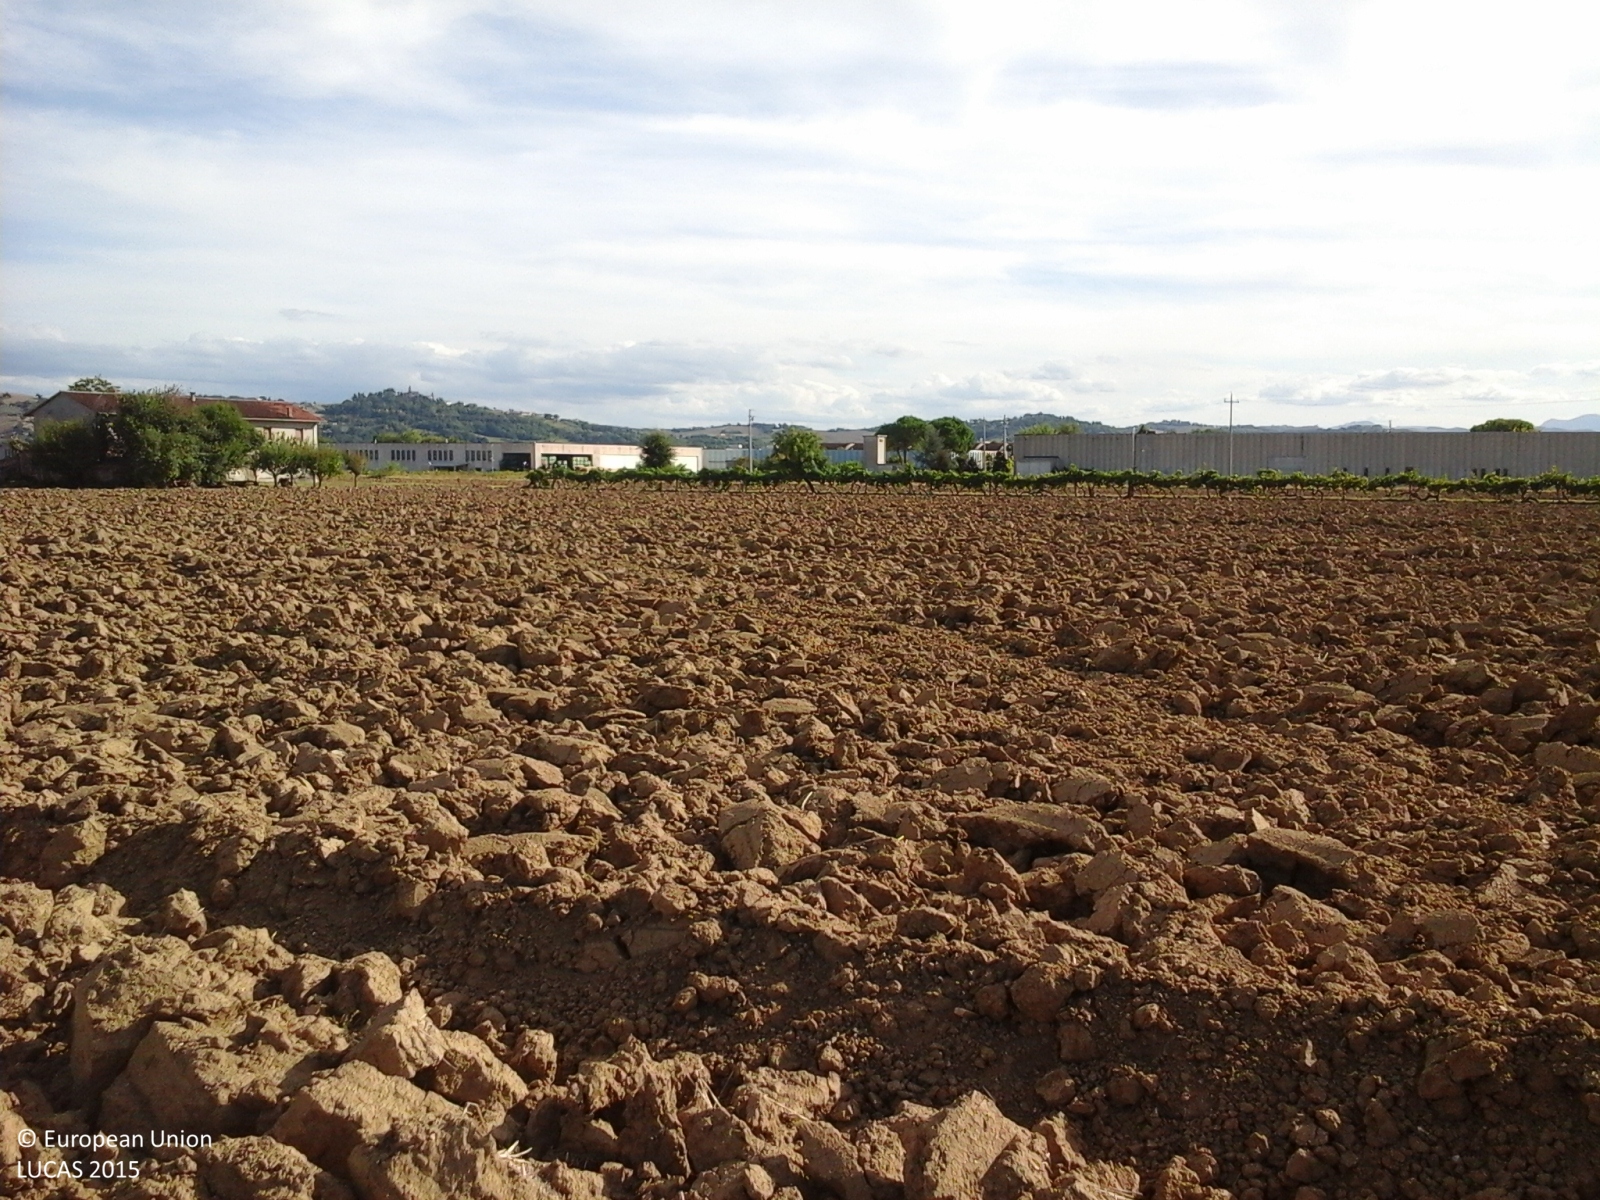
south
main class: Grassland
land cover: Spontaneously vegetated surfaces
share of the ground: > 75 %
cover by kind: herbaceous plants 100 %
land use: Fallow land
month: September
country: IT
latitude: 43.7675
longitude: 12.9371
